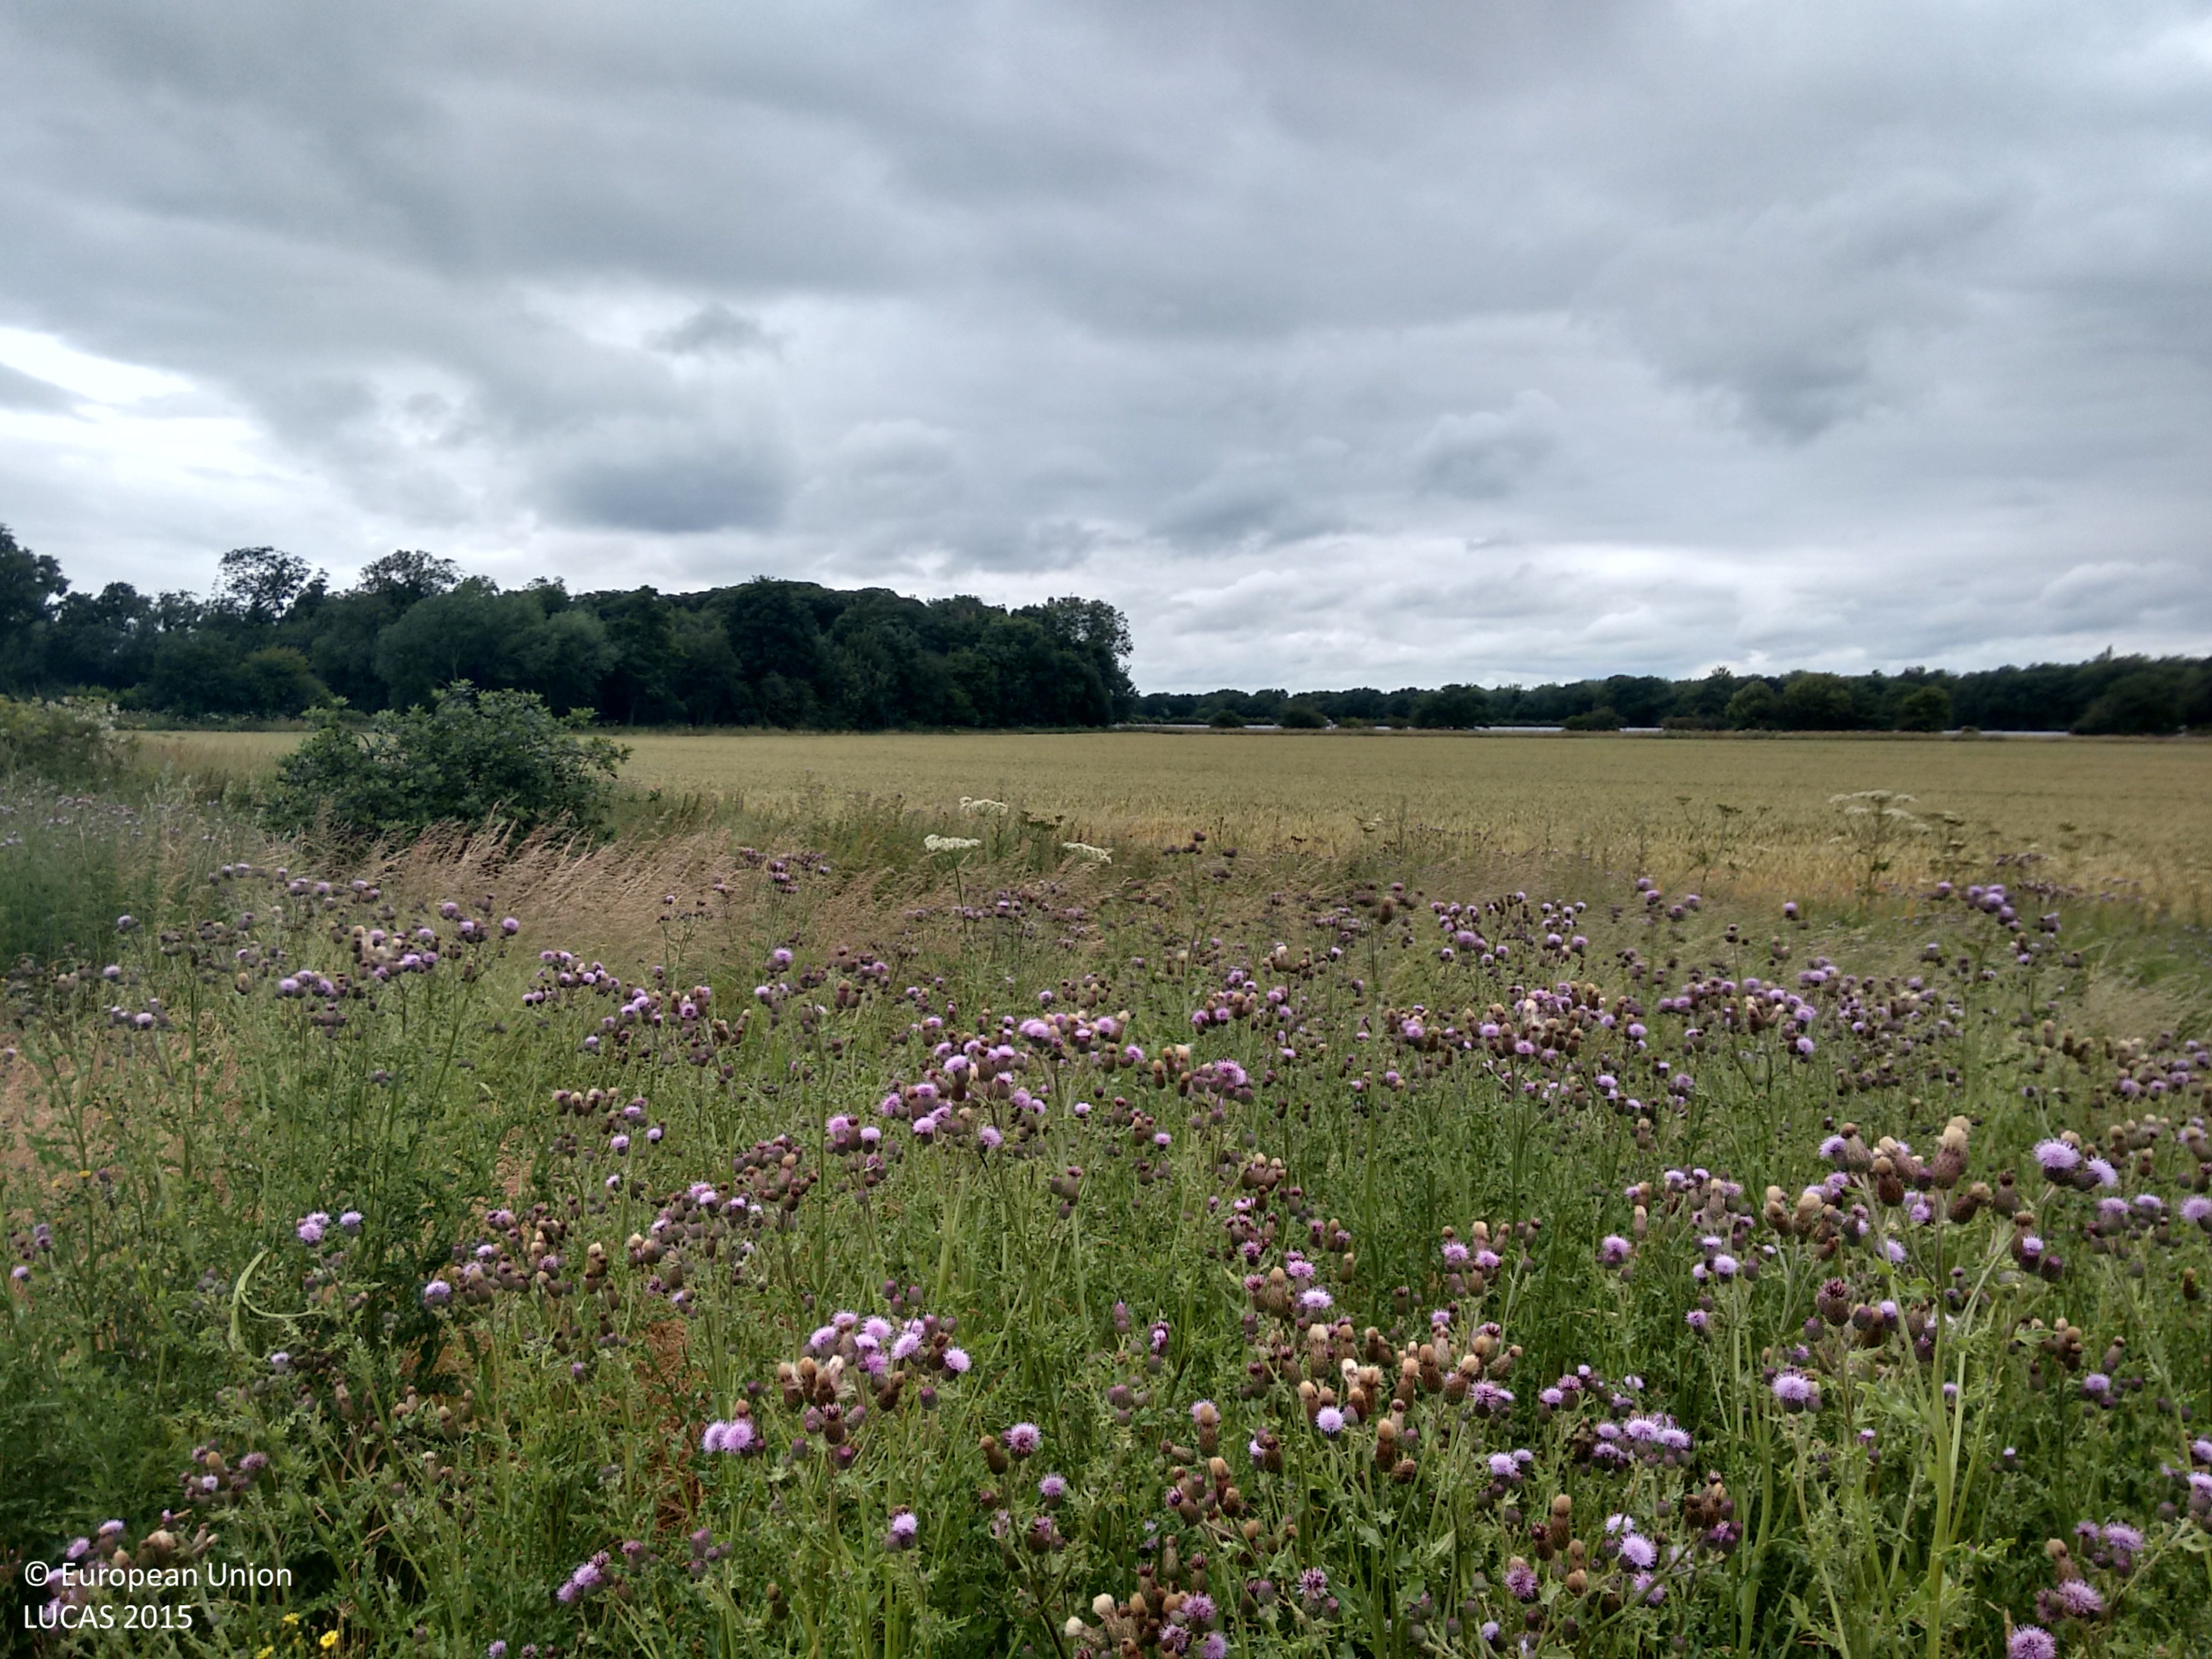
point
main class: Cropland
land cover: Common wheat
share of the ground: > 75 %
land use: Agriculture (excluding fallow land and kitchen gardens)
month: July
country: GB
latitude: 53.3533
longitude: -0.9957
